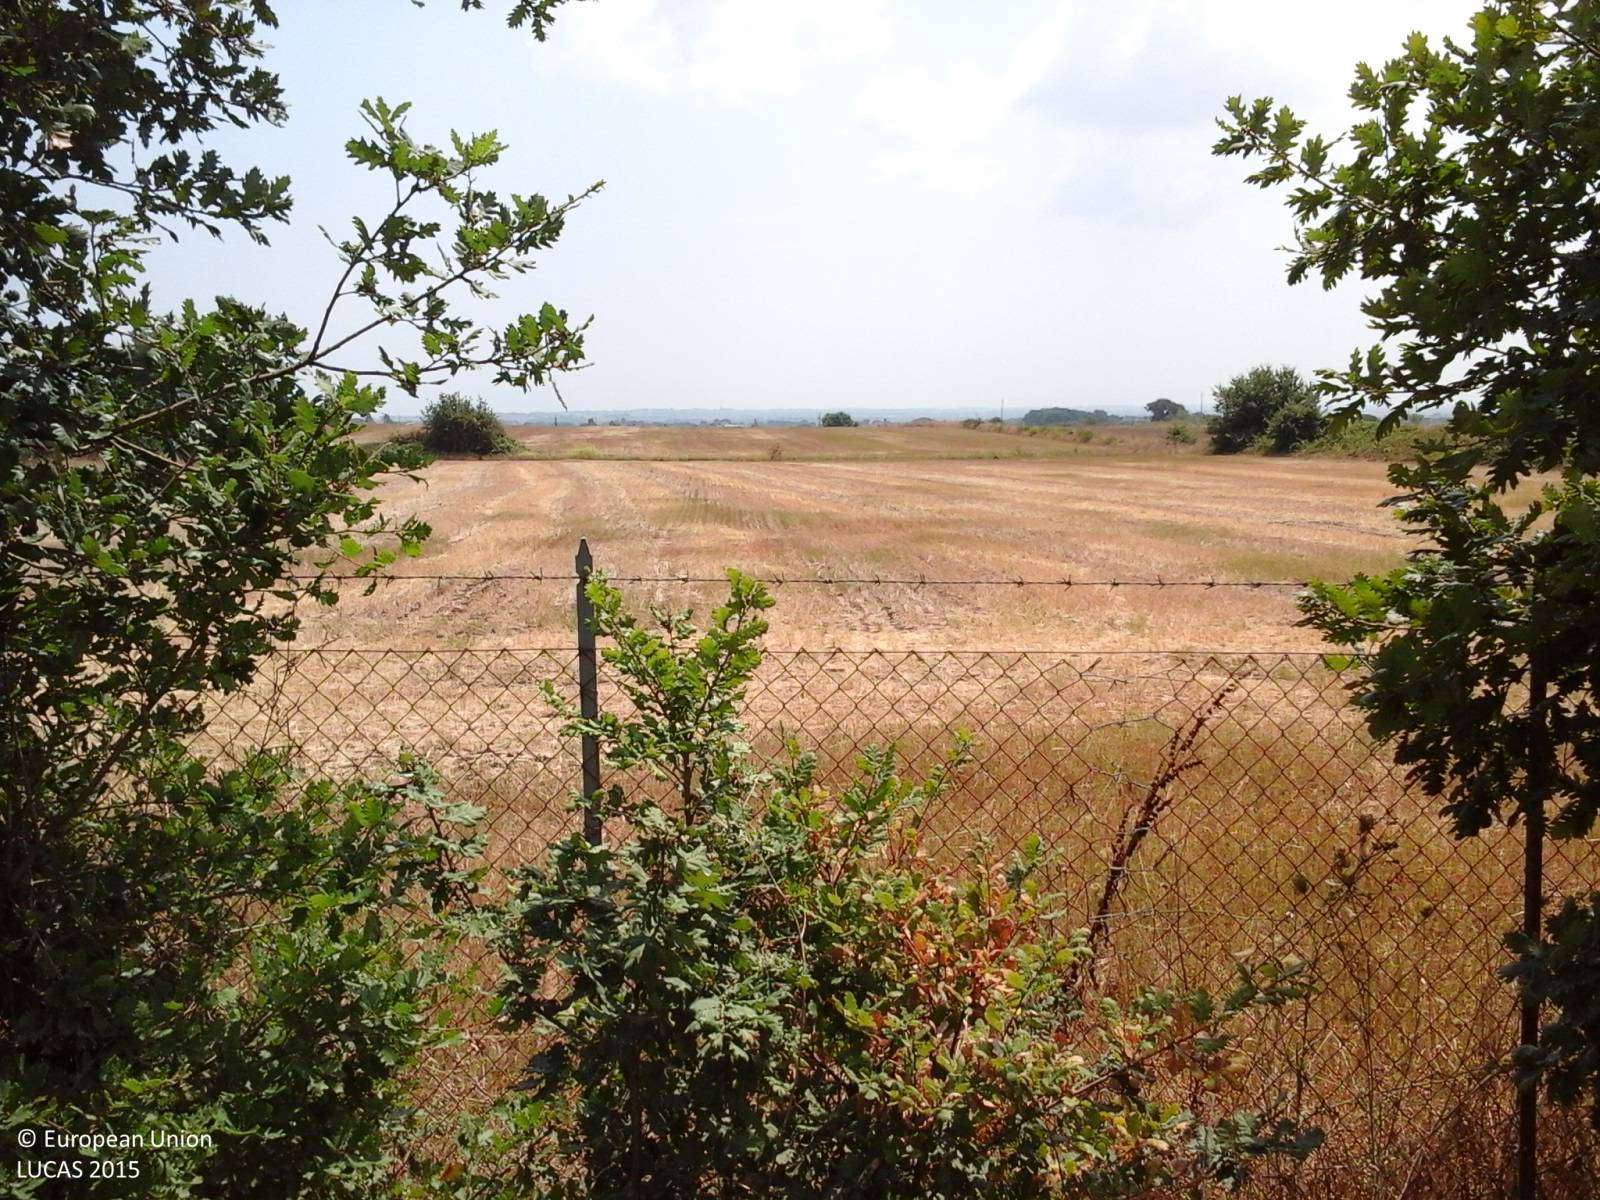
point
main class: Cropland
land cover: Temporary grasslands
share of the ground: > 75 %
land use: Agriculture (excluding fallow land and kitchen gardens)
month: July
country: IT
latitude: 42.0327
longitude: 12.2505
